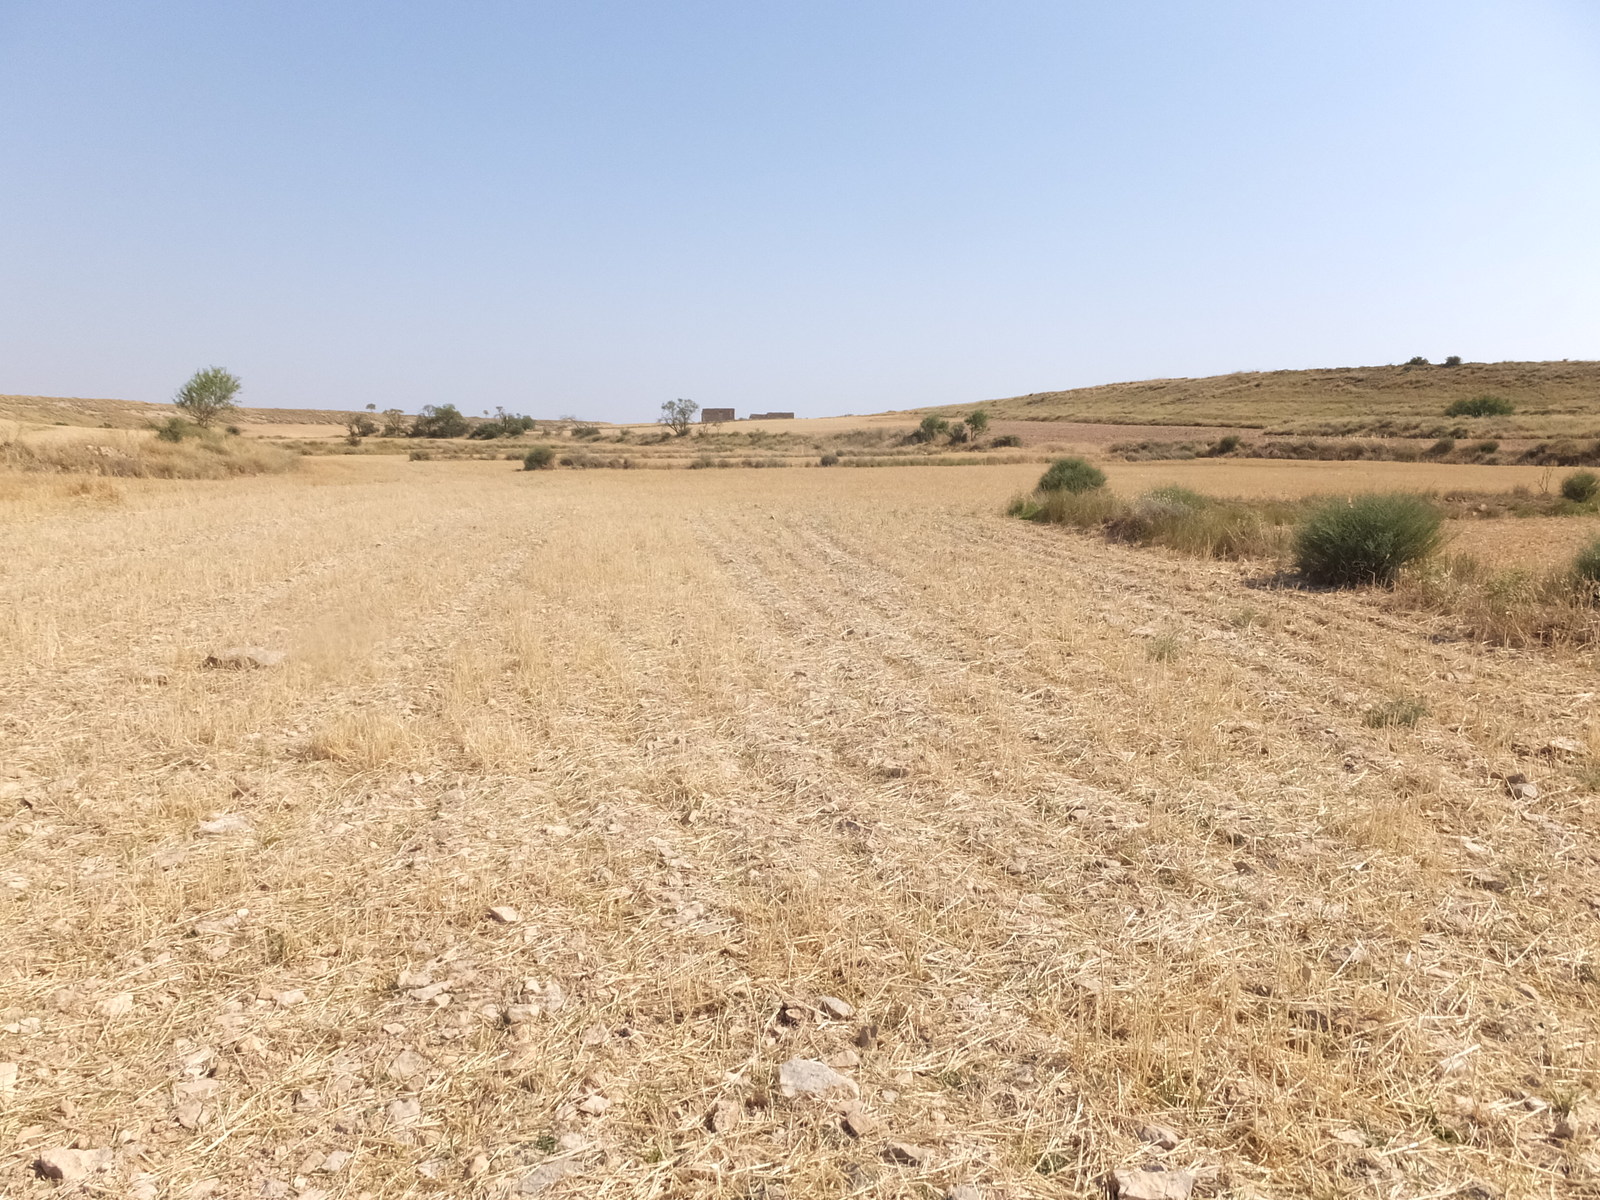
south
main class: Cropland
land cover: Barley
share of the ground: < 10 %
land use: Agriculture (excluding fallow land and kitchen gardens)
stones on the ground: < 10 %
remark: Harvested field
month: July
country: ES
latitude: 41.5740
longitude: 0.1633
